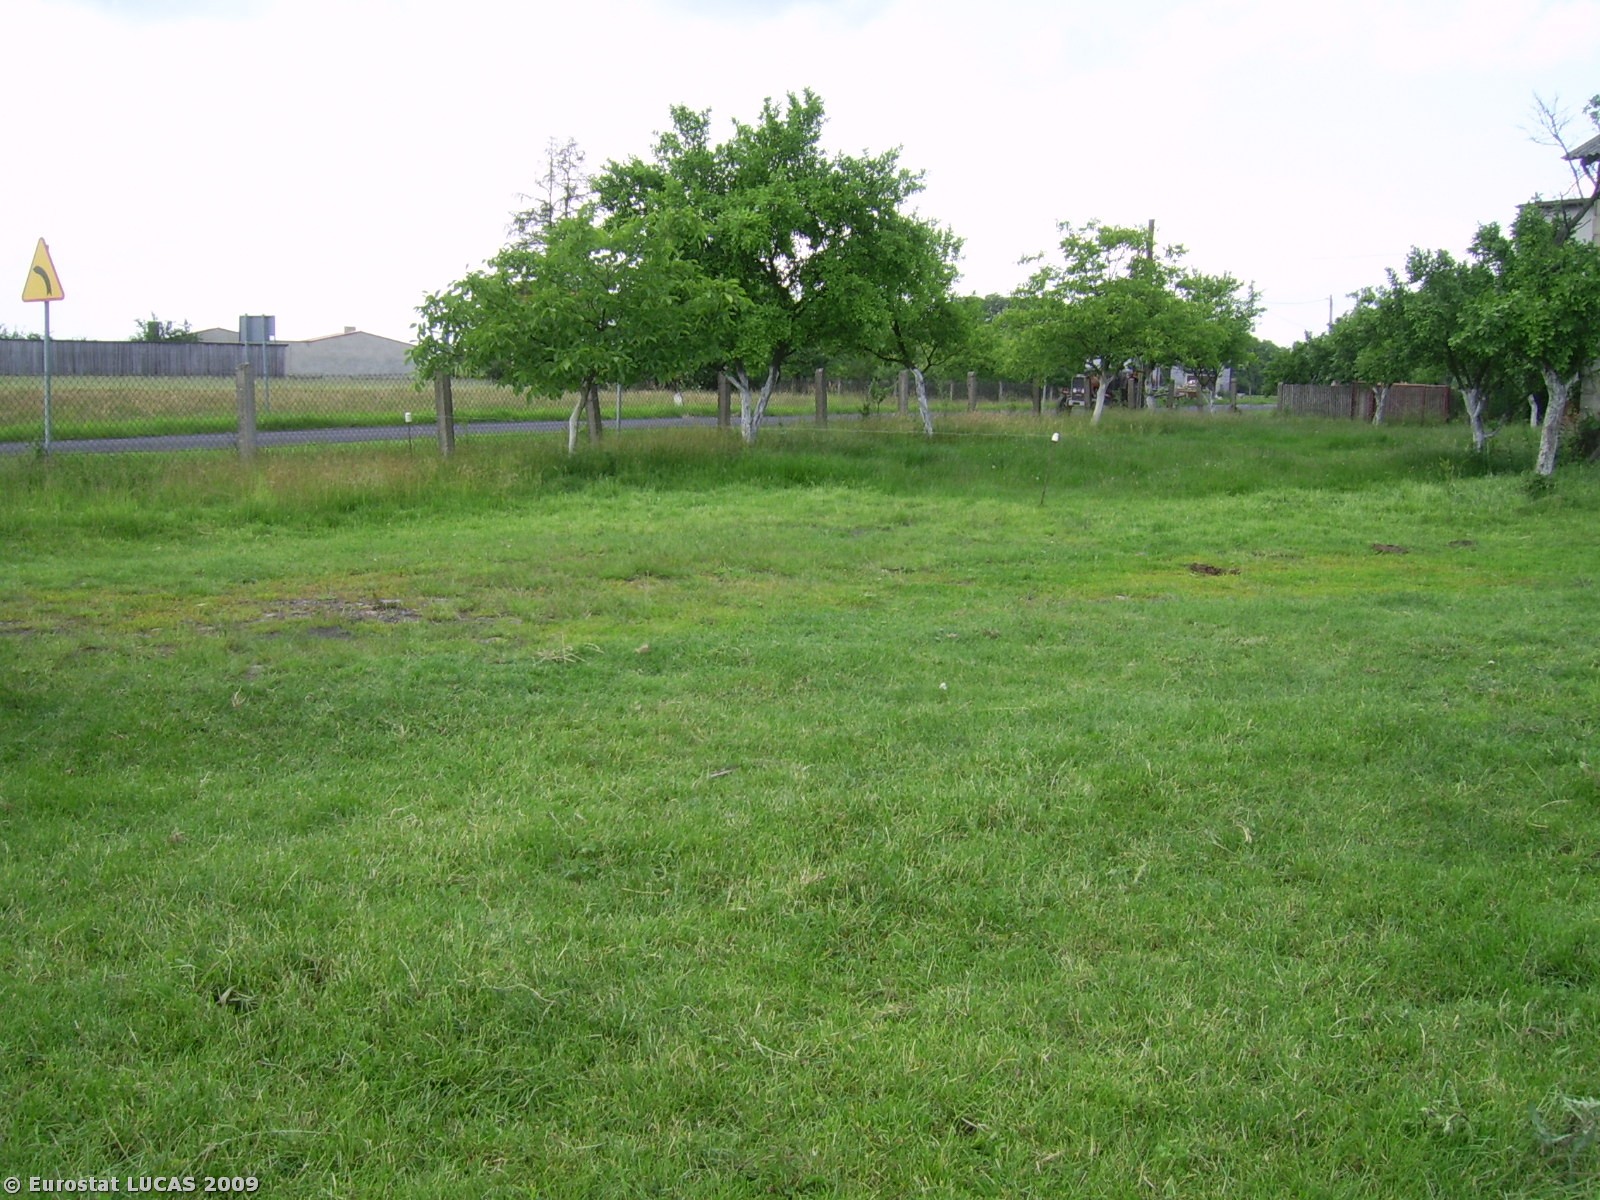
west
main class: Grassland
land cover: Grassland without tree/shrub cover
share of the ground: > 75 %
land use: Agriculture (excluding fallow land and kitchen gardens)
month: June
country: PL
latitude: 51.5300
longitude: 17.9873
